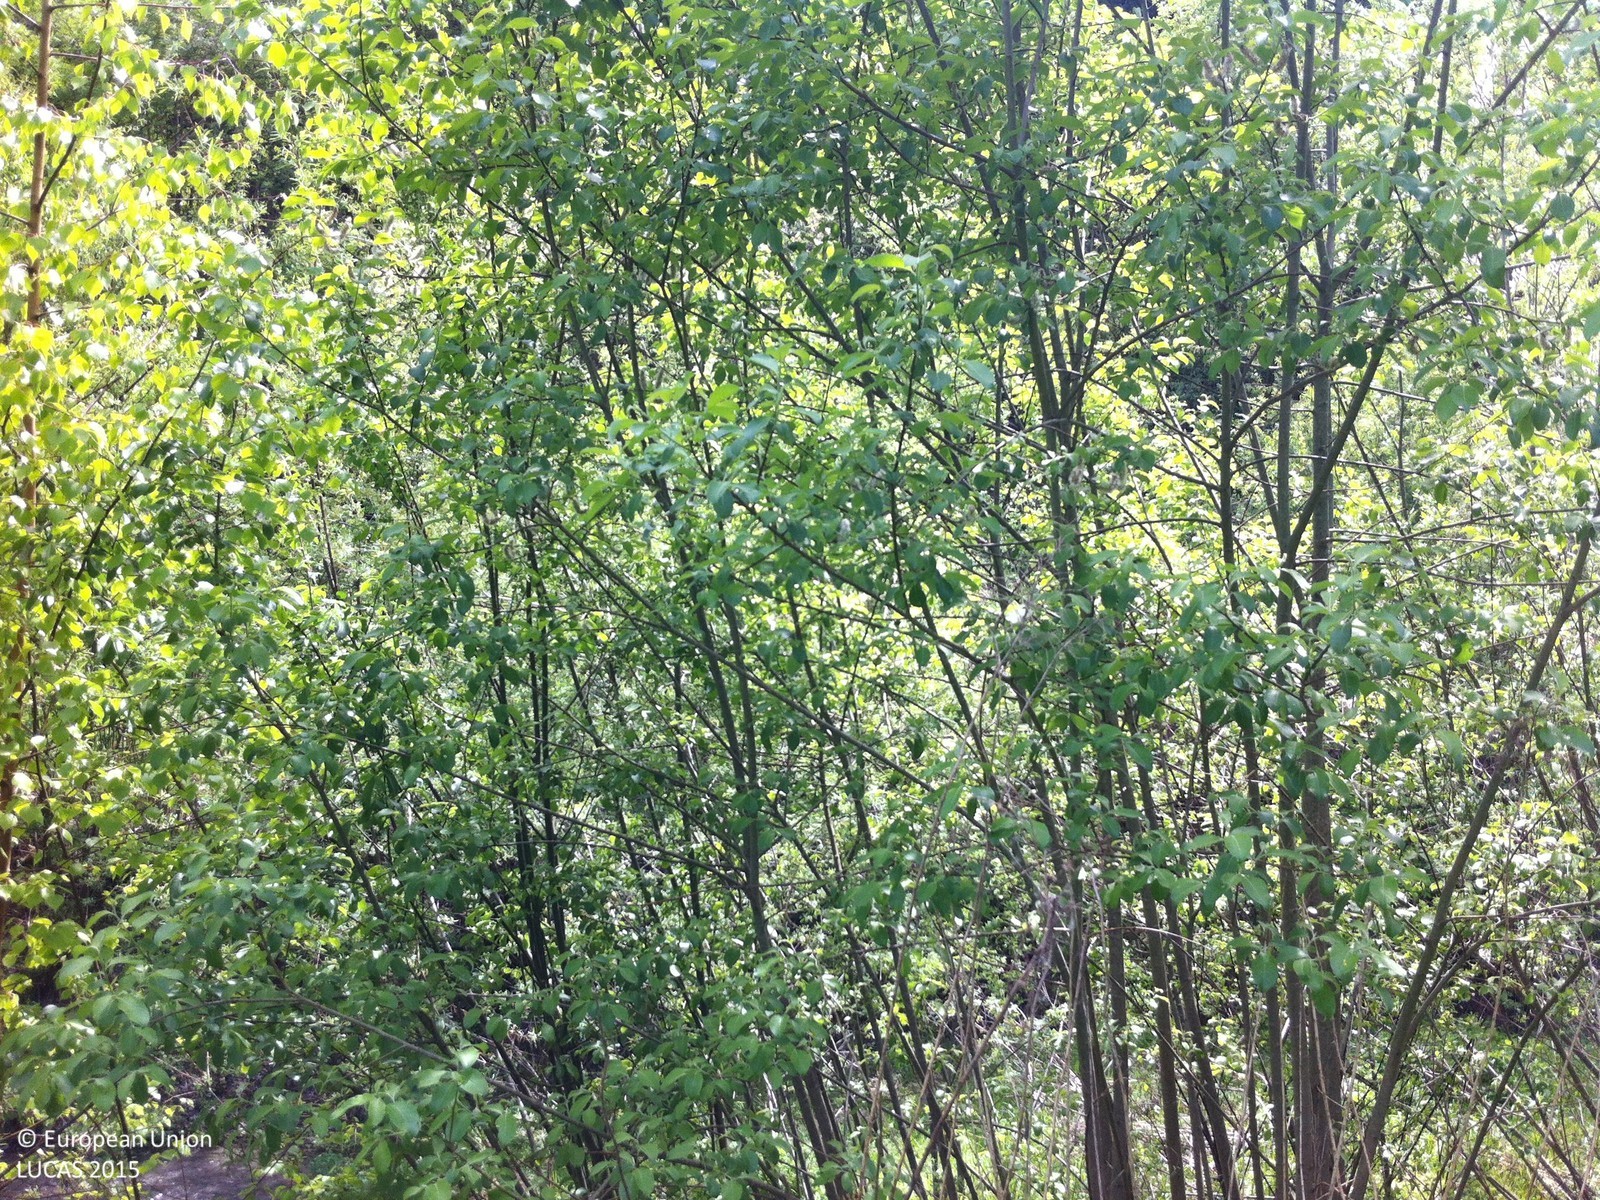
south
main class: Grassland
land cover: Grassland without tree/shrub cover
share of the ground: > 75 %
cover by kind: herbaceous plants 100 %
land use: Agriculture (excluding fallow land and kitchen gardens)
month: May
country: AT
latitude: 47.2437
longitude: 11.3067
